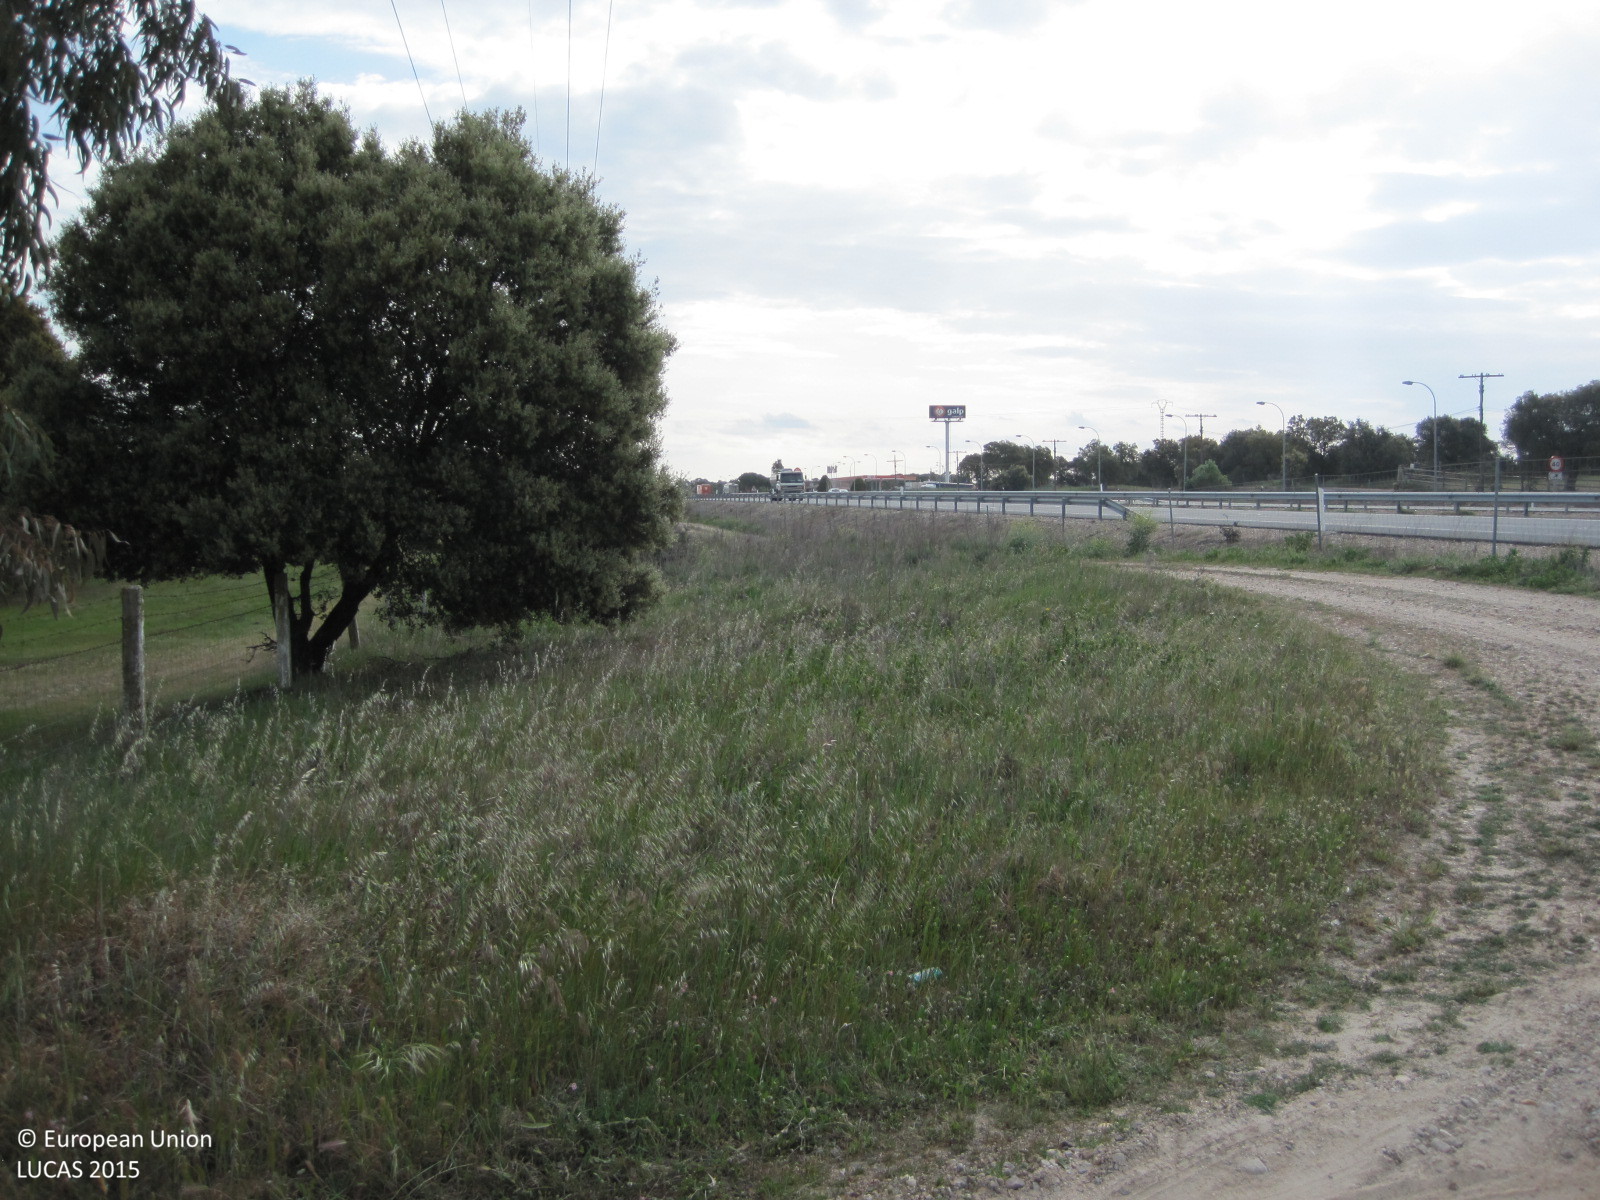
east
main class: Grassland
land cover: Grassland with sparse tree/shrub cover
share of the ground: > 75 %
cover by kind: herbaceous plants 95 %, broadleaved forest trees 5 %
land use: Agriculture (excluding fallow land and kitchen gardens)
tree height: > 5 m
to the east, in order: Grassland with sparse tree/shrub cover; Grassland without tree/shrub cover; Grassland with sparse tree/shrub cover
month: April
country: ES
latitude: 39.9235
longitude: -5.0624
